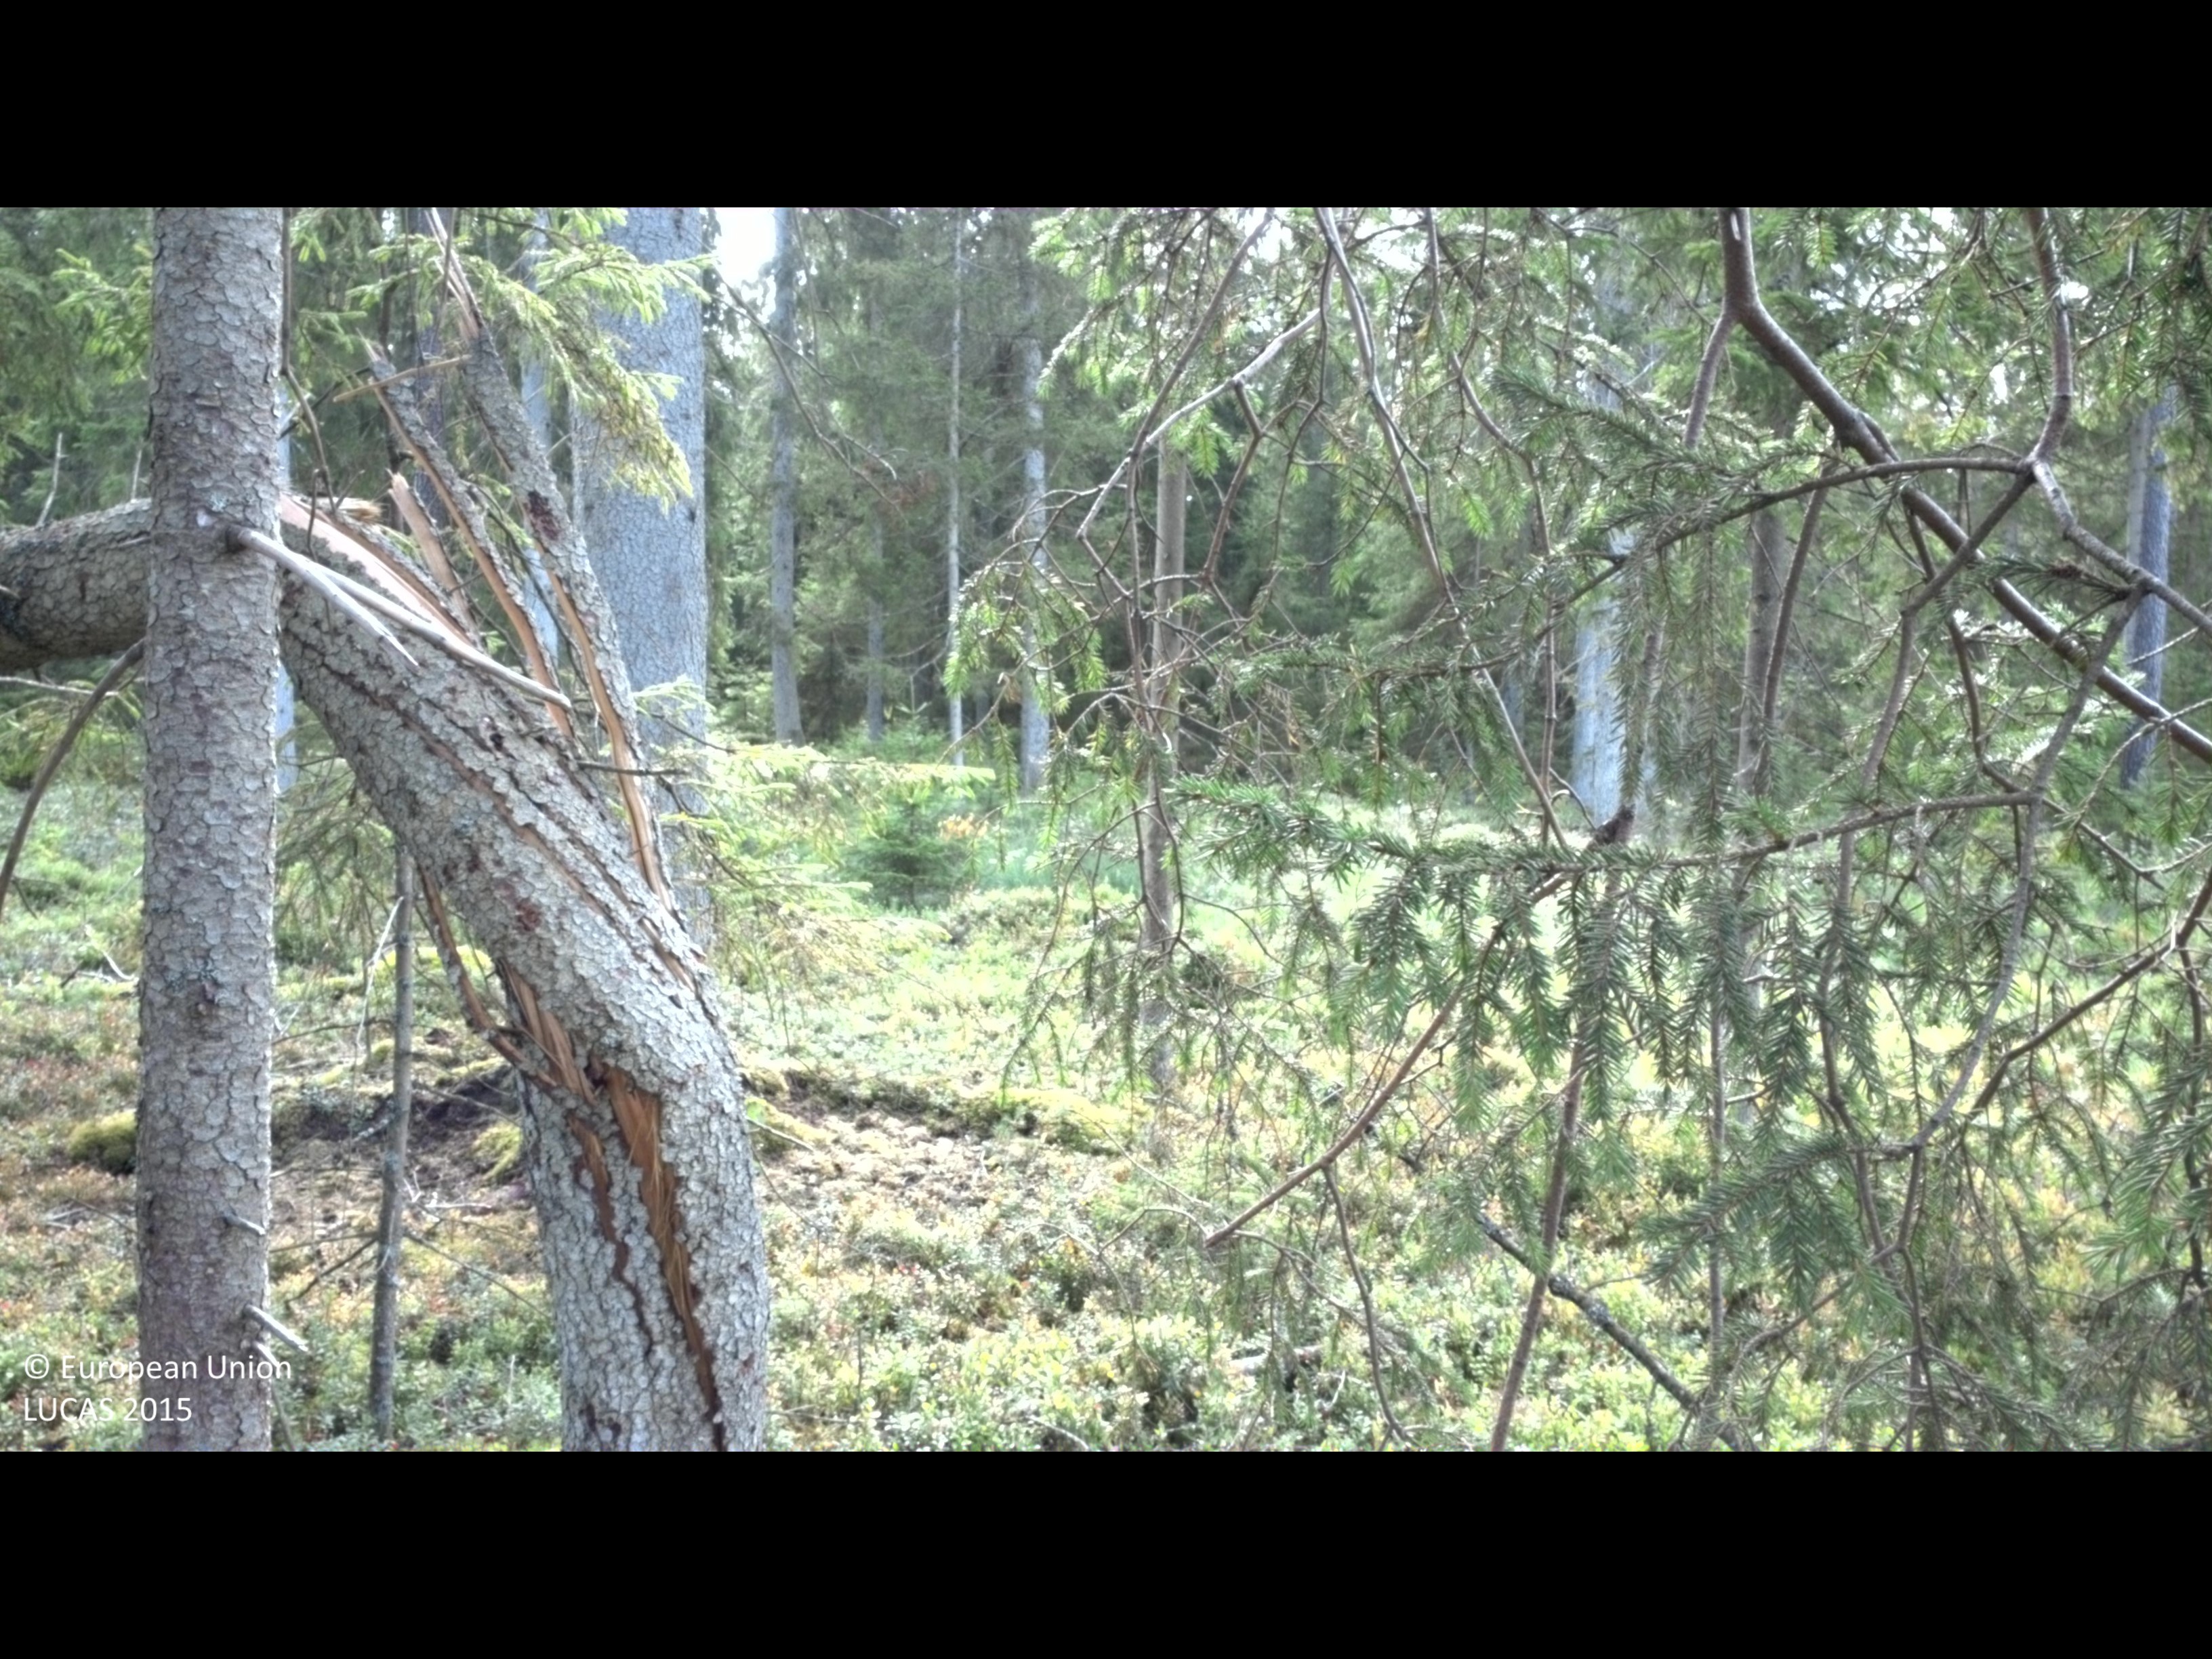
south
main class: Woodland
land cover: Spruce dominated coniferous woodland
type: boreal forest
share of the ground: 50 - 75 %
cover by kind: coniferous forest trees 70 %, shrubs 30 %
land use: Forestry
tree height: > 5 m
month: August
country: SE
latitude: 57.1751
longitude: 13.8169
